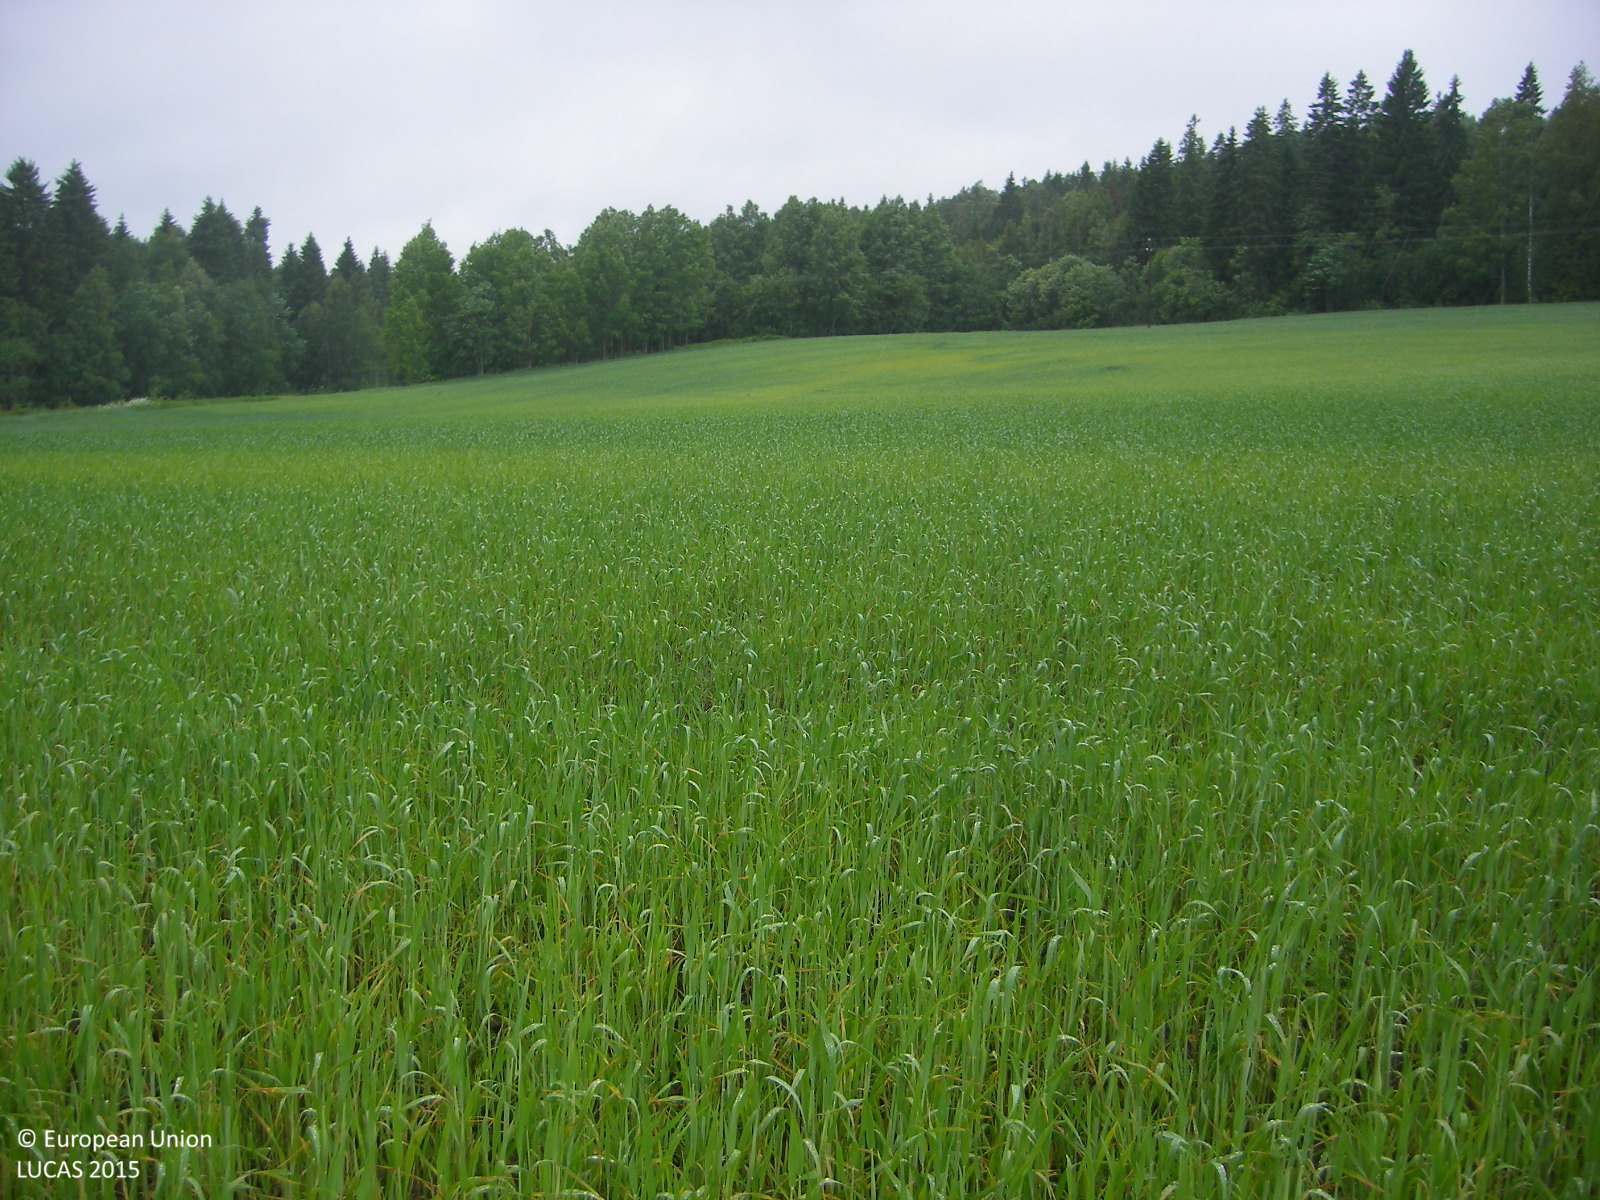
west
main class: Cropland
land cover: Common wheat
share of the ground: > 75 %
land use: Agriculture (excluding fallow land and kitchen gardens)
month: June
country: FI
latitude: 60.1287
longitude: 24.0865
